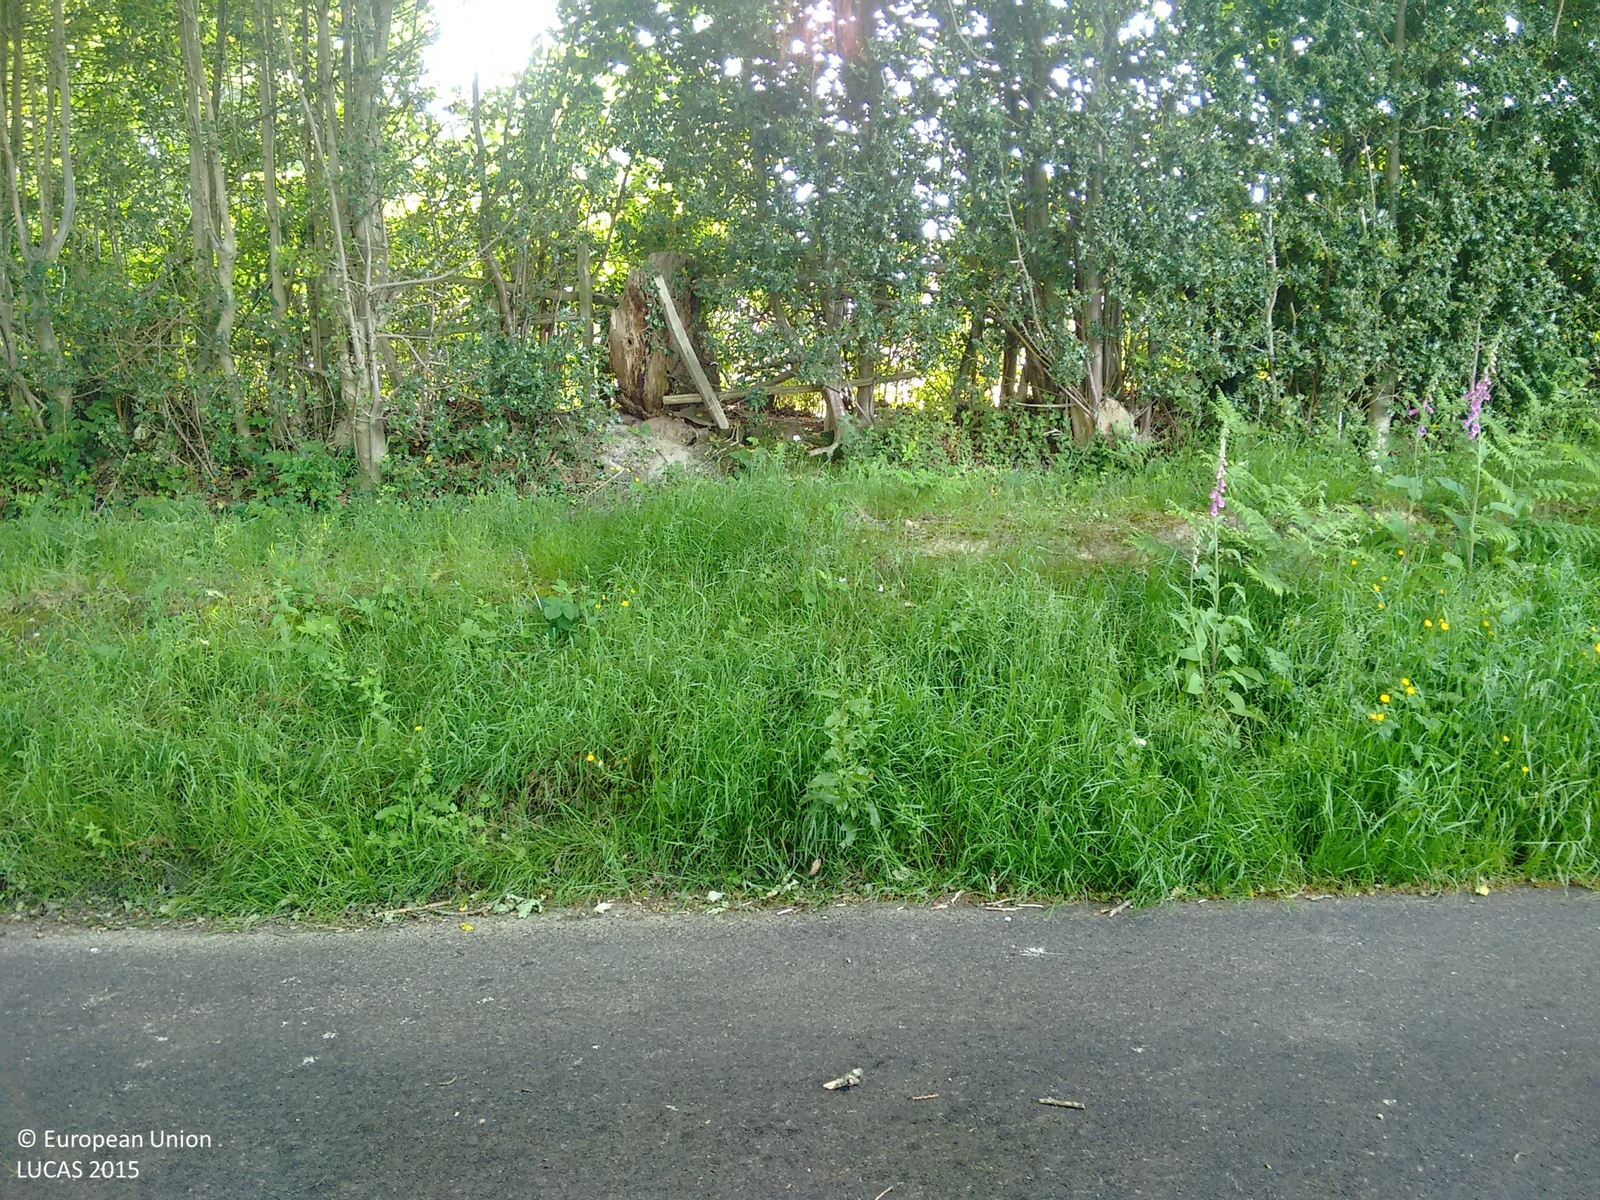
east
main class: Grassland
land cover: Grassland with sparse tree/shrub cover
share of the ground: > 75 %
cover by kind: herbaceous plants 95 %, broadleaved forest trees 5 %
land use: Agriculture (excluding fallow land and kitchen gardens)
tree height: > 5 m
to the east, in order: Grassland with sparse tree/shrub cover; Broadleaved woodland; Fences; Broadleaved woodland; Paved roads, cycling and walking lanes; Grass margins; Broadleaved woodland; Fences; Broadleaved woodland; Grassland without tree/shrub cover; Broadleaved woodland; Artificial constructions in urban areas; Managed hedges; Grassland without tree/shrub cover; Managed hedges; Grassland without tree/shrub cover; Shrubland with sparse tree cover
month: June
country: GB
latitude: 50.9855
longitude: 0.3265
